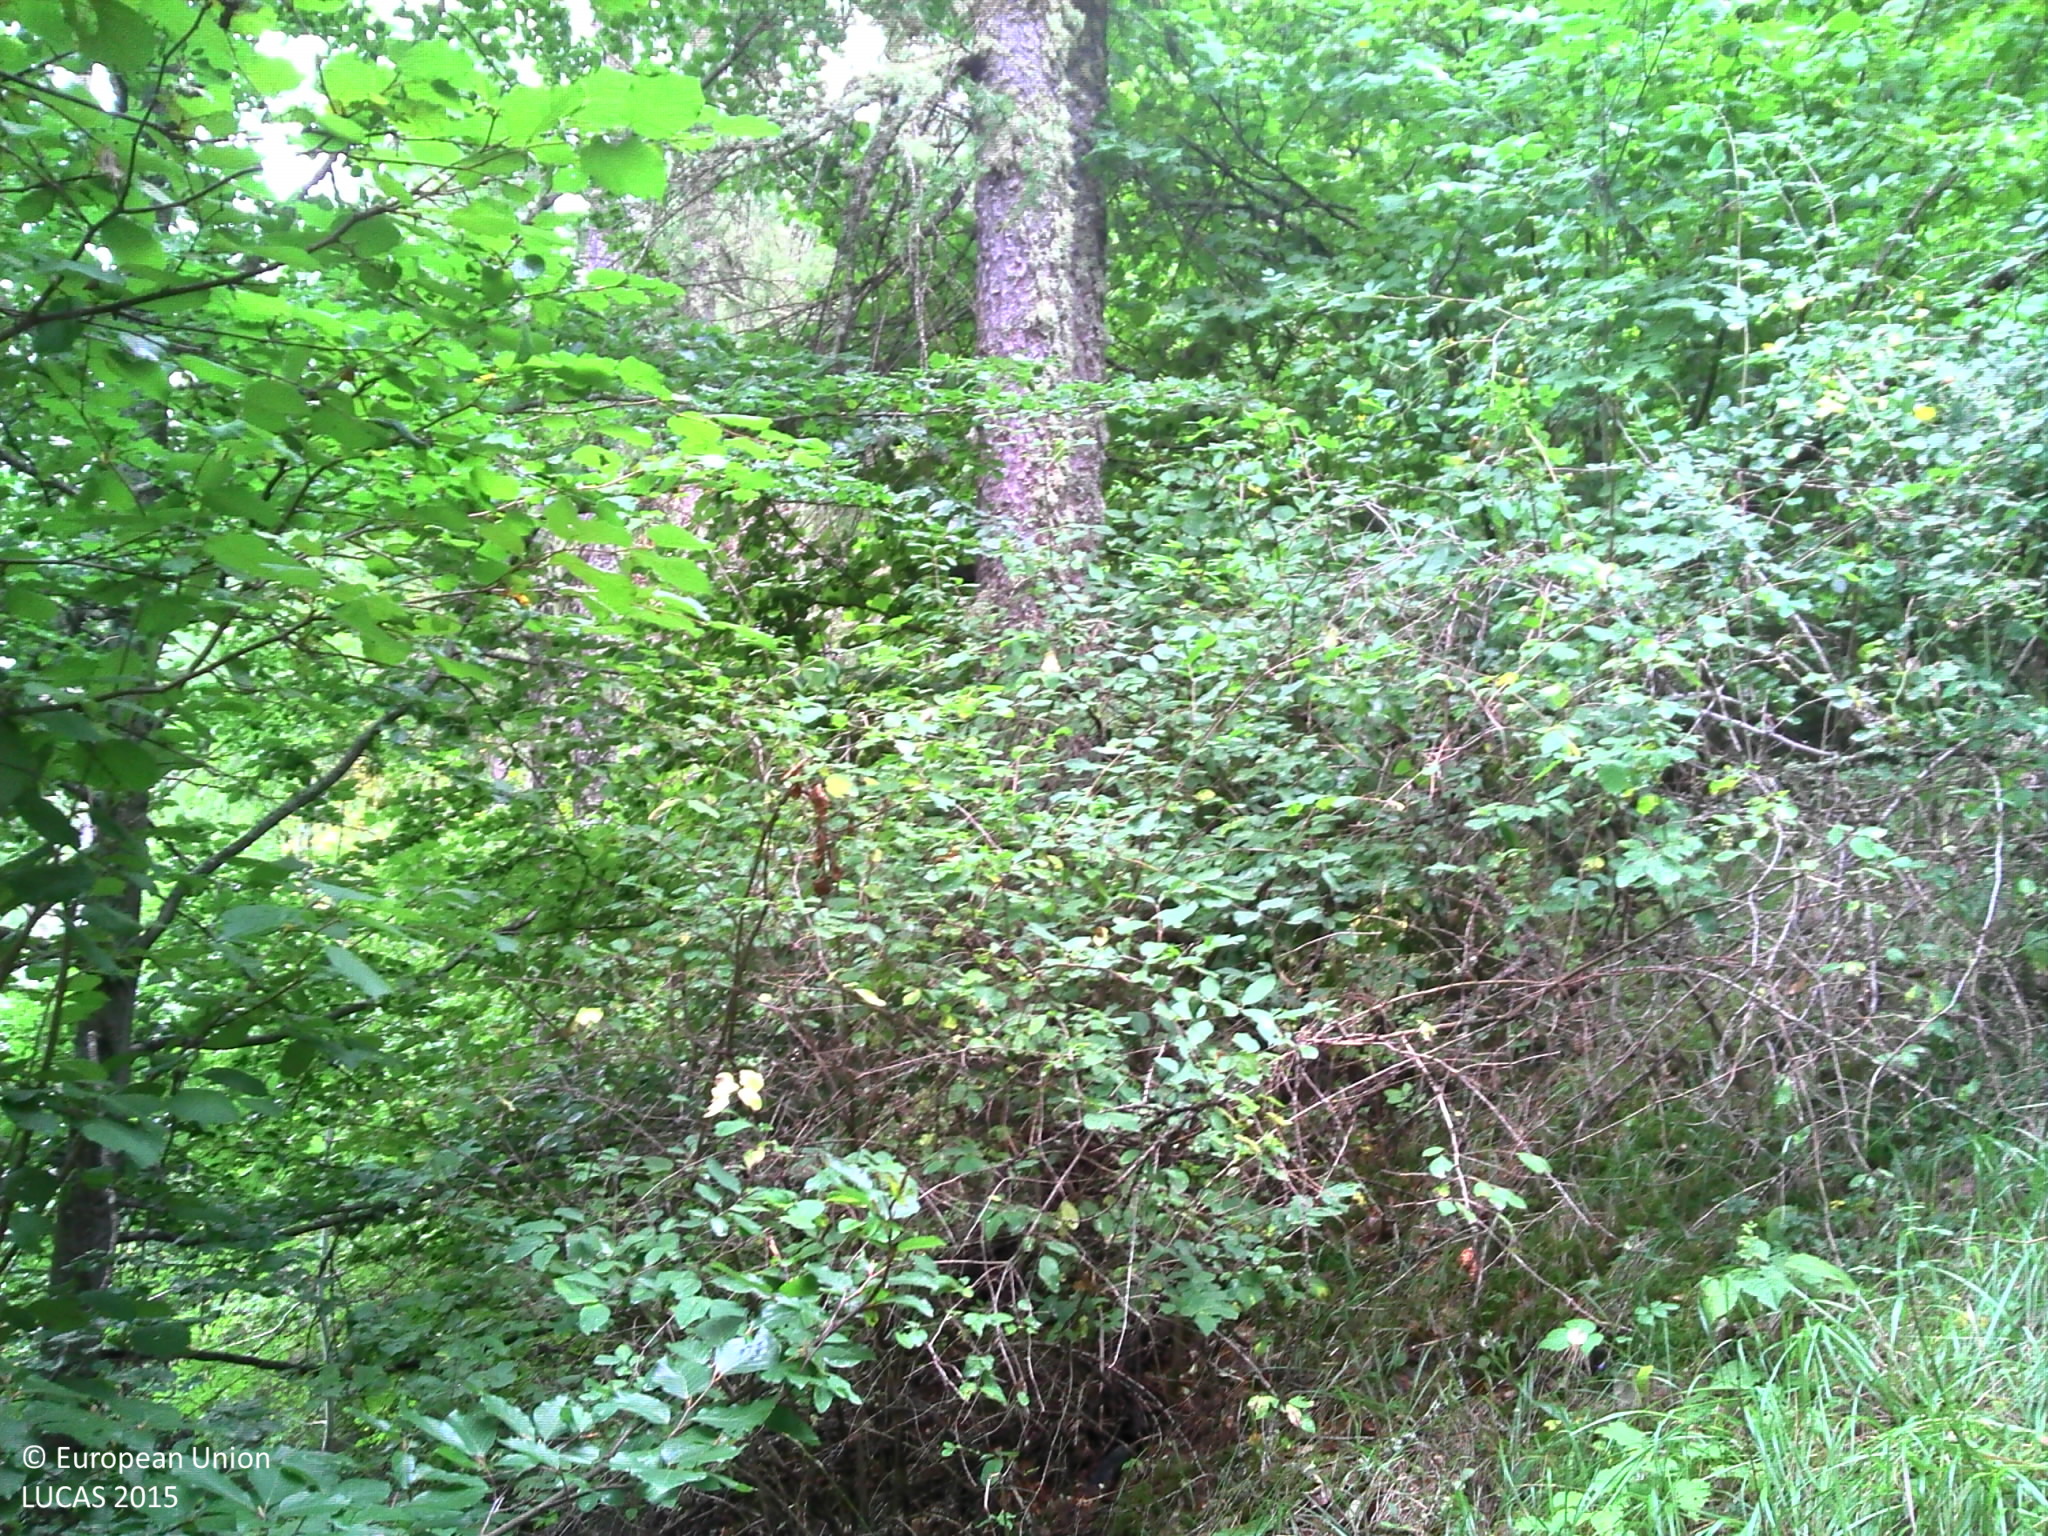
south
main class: Woodland
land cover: Pine dominated mixed woodland
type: alpine coniferous forest
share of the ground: > 75 %
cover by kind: coniferous forest trees 60 %, broadleaved forest trees 25 %, herbaceous plants 10 %, shrubs 5 %
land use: Forestry
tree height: > 5 m
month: September
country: FR
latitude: 44.7163
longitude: 6.2569
